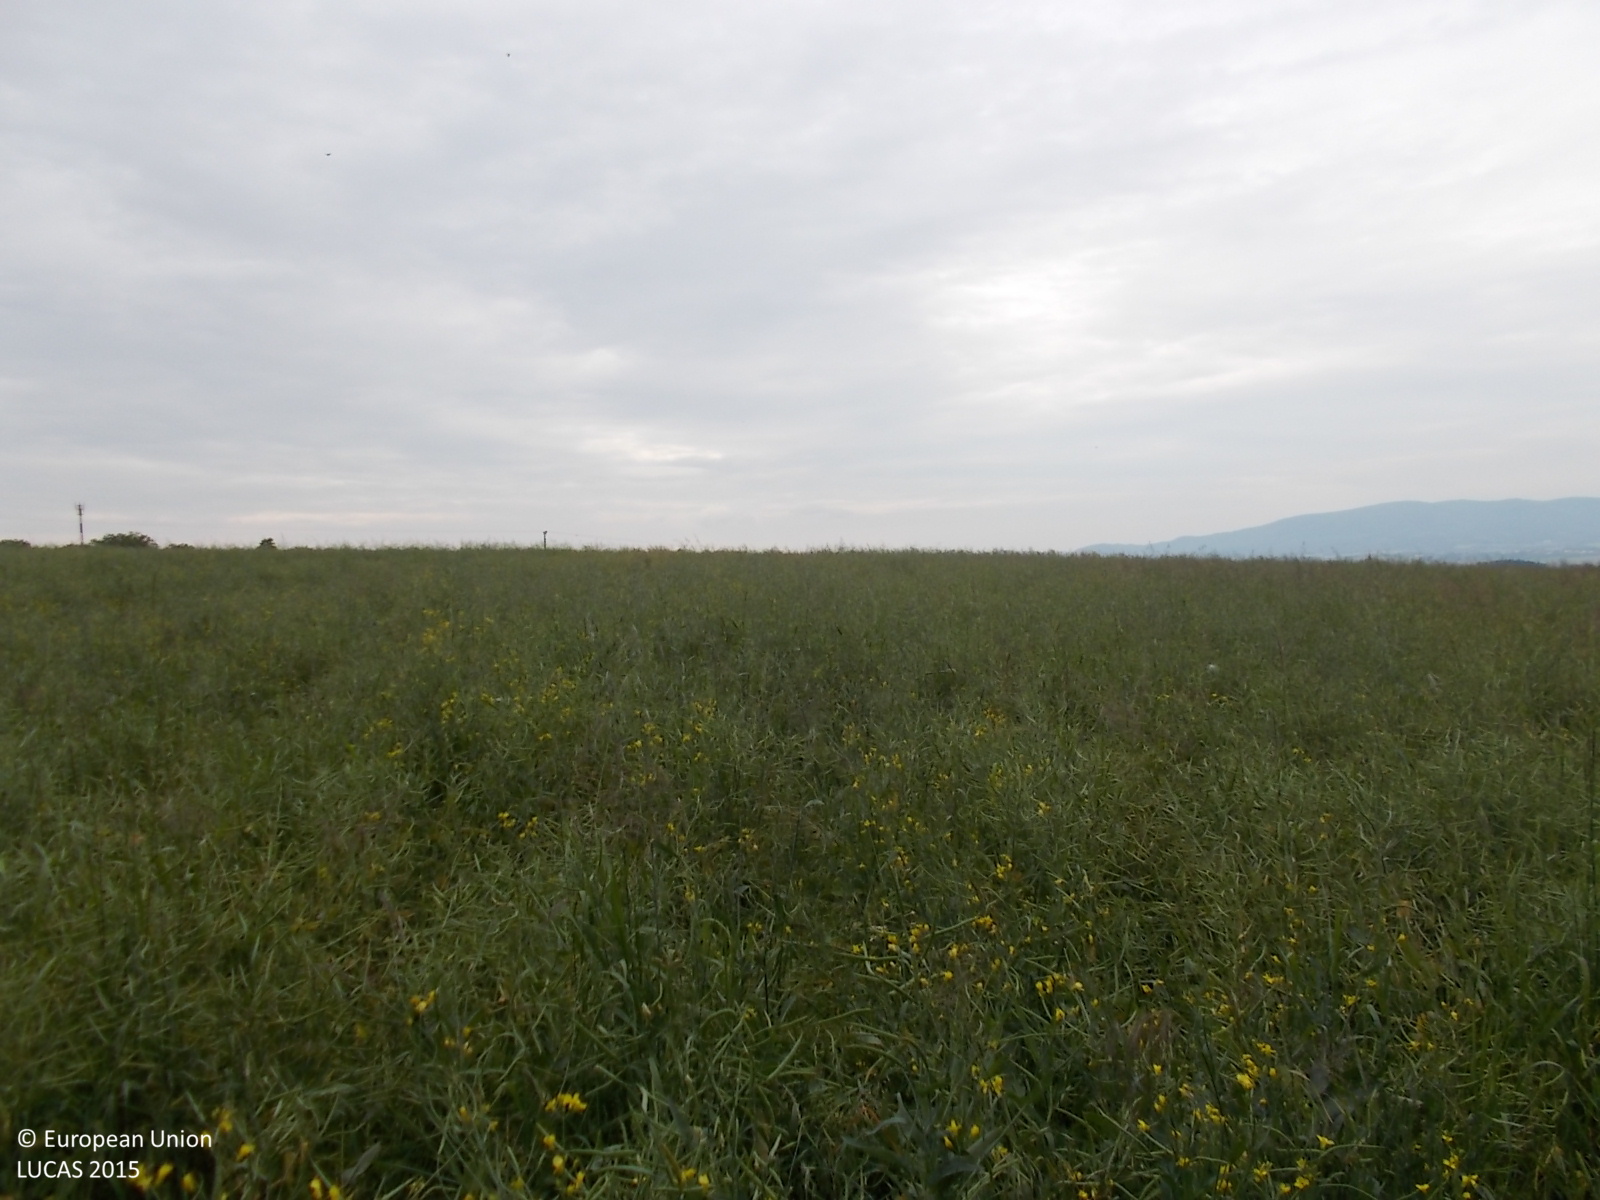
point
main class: Cropland
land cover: Rape and turnip rape
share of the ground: > 75 %
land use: Agriculture (excluding fallow land and kitchen gardens)
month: June
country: CZ
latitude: 49.5078
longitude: 17.7055
